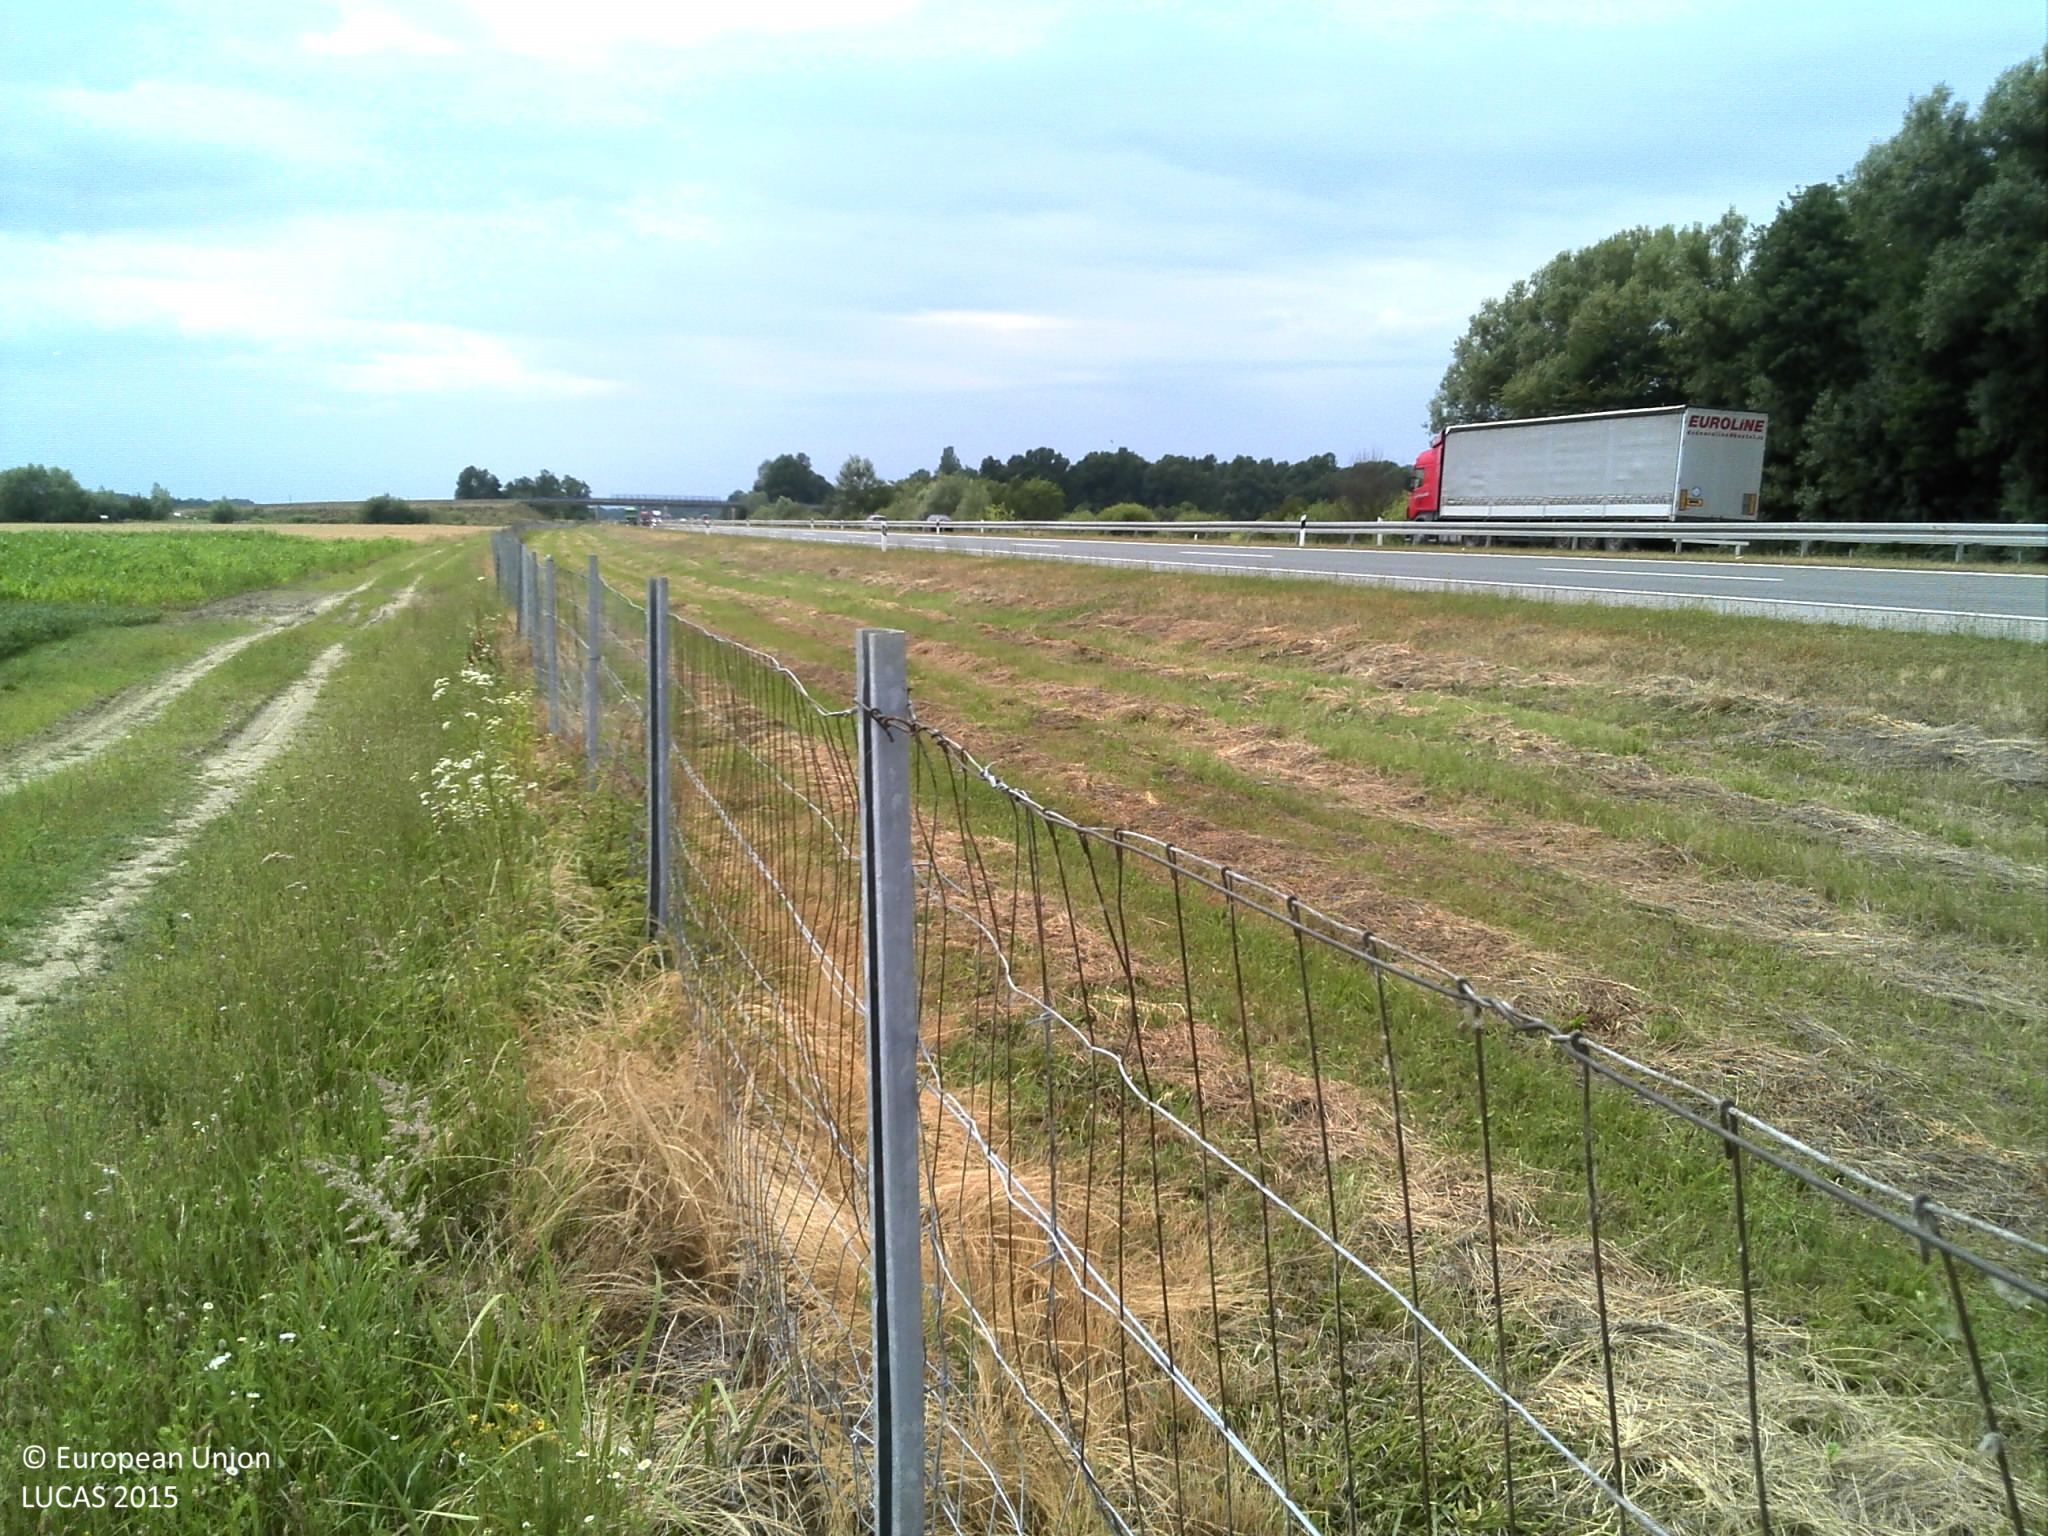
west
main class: Grassland
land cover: Spontaneously vegetated surfaces
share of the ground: > 75 %
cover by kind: herbaceous plants 95 %, lichens and mosses 5 %
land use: Semi-natural and natural areas not in use
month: June
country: HR
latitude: 45.2193
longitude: 17.5011
